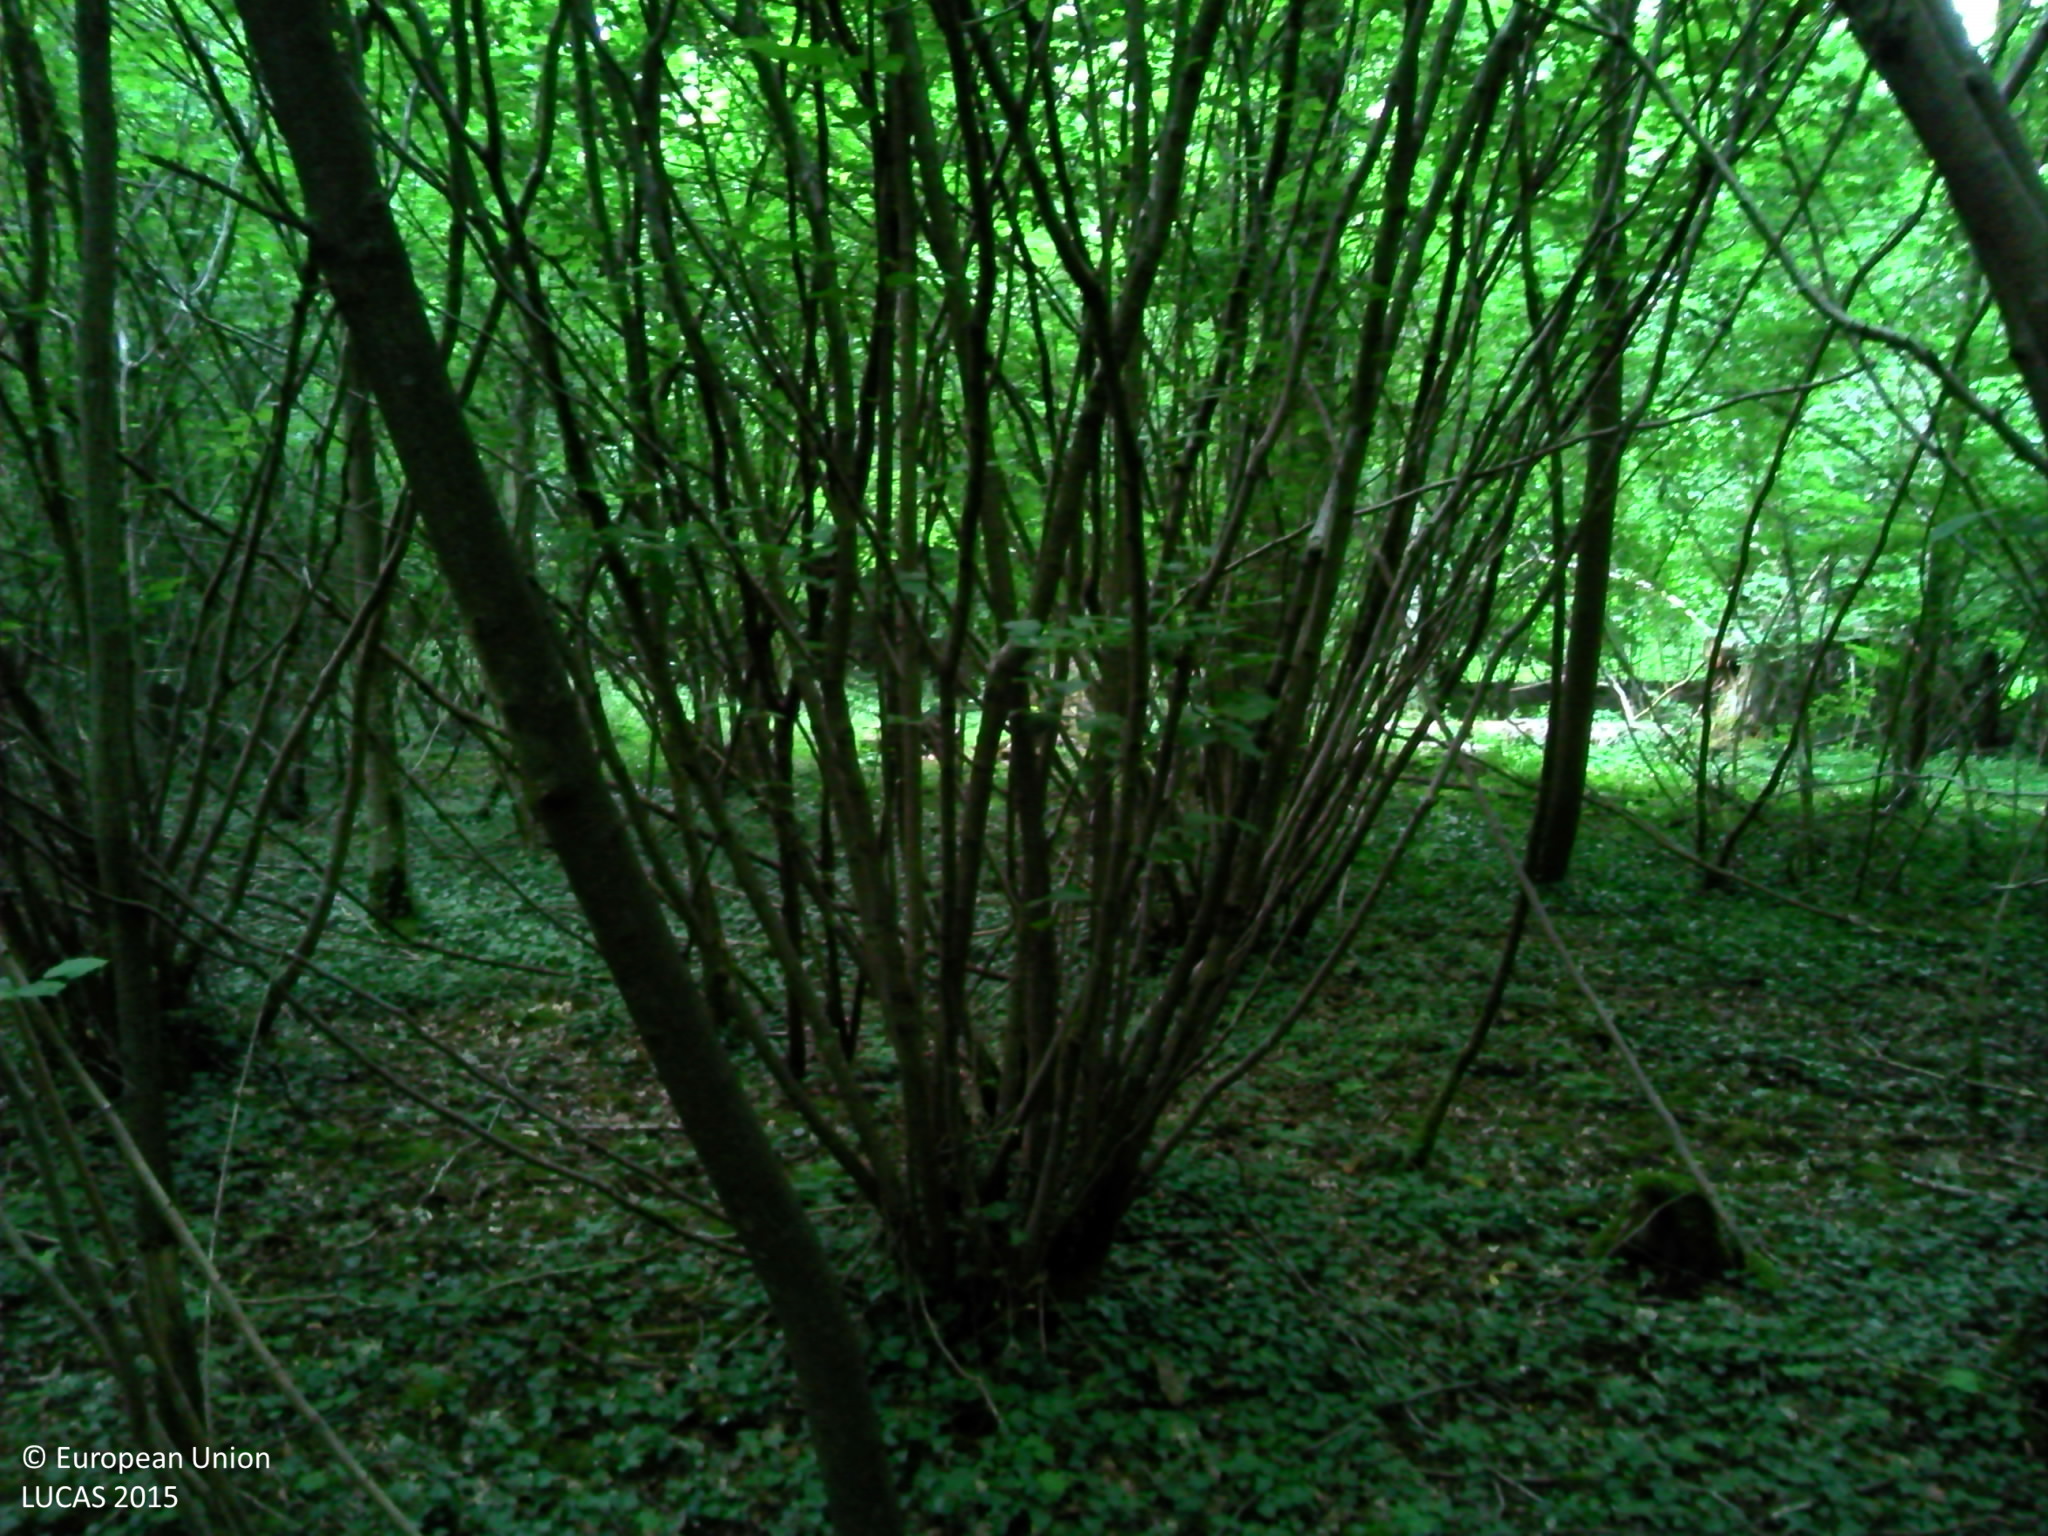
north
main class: Woodland
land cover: Broadleaved woodland
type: mesophytic deciduous forest
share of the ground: > 75 %
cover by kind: broadleaved forest trees 80 %, herbaceous plants 15 %, consolidated bare surface 5 %
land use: Forestry
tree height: > 5 m
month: June
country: FR
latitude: 49.2287
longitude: 1.2049
